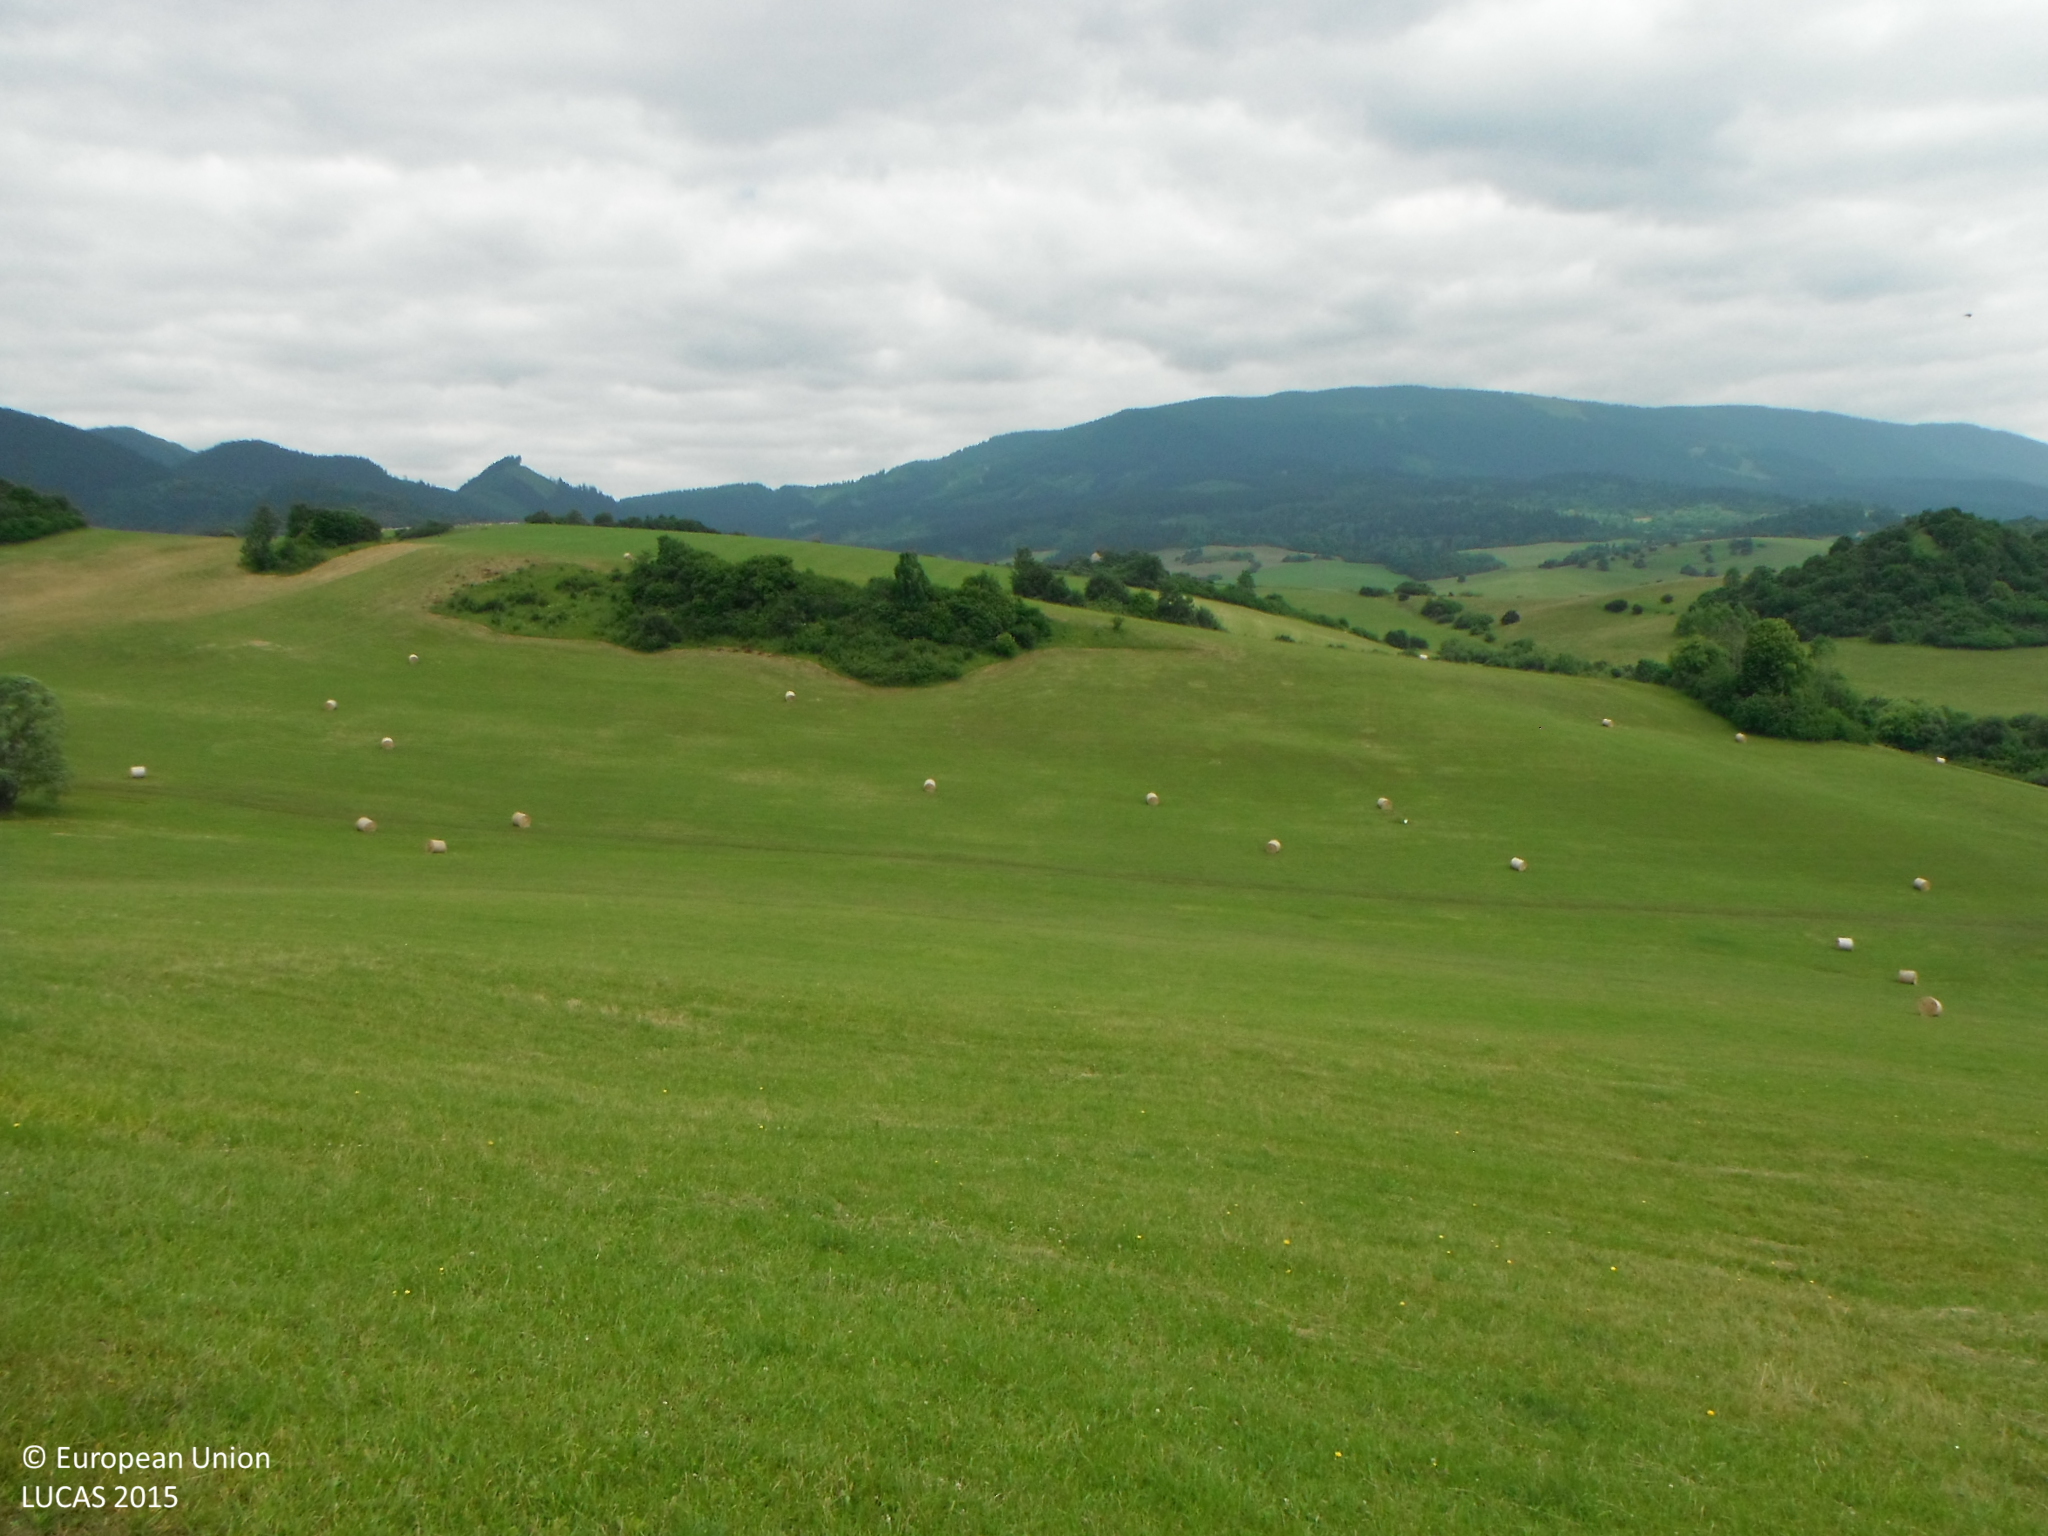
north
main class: Grassland
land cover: Grassland without tree/shrub cover
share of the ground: > 75 %
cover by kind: herbaceous plants 100 %
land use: Agriculture (excluding fallow land and kitchen gardens)
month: June
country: SK
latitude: 49.2114
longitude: 19.2349
